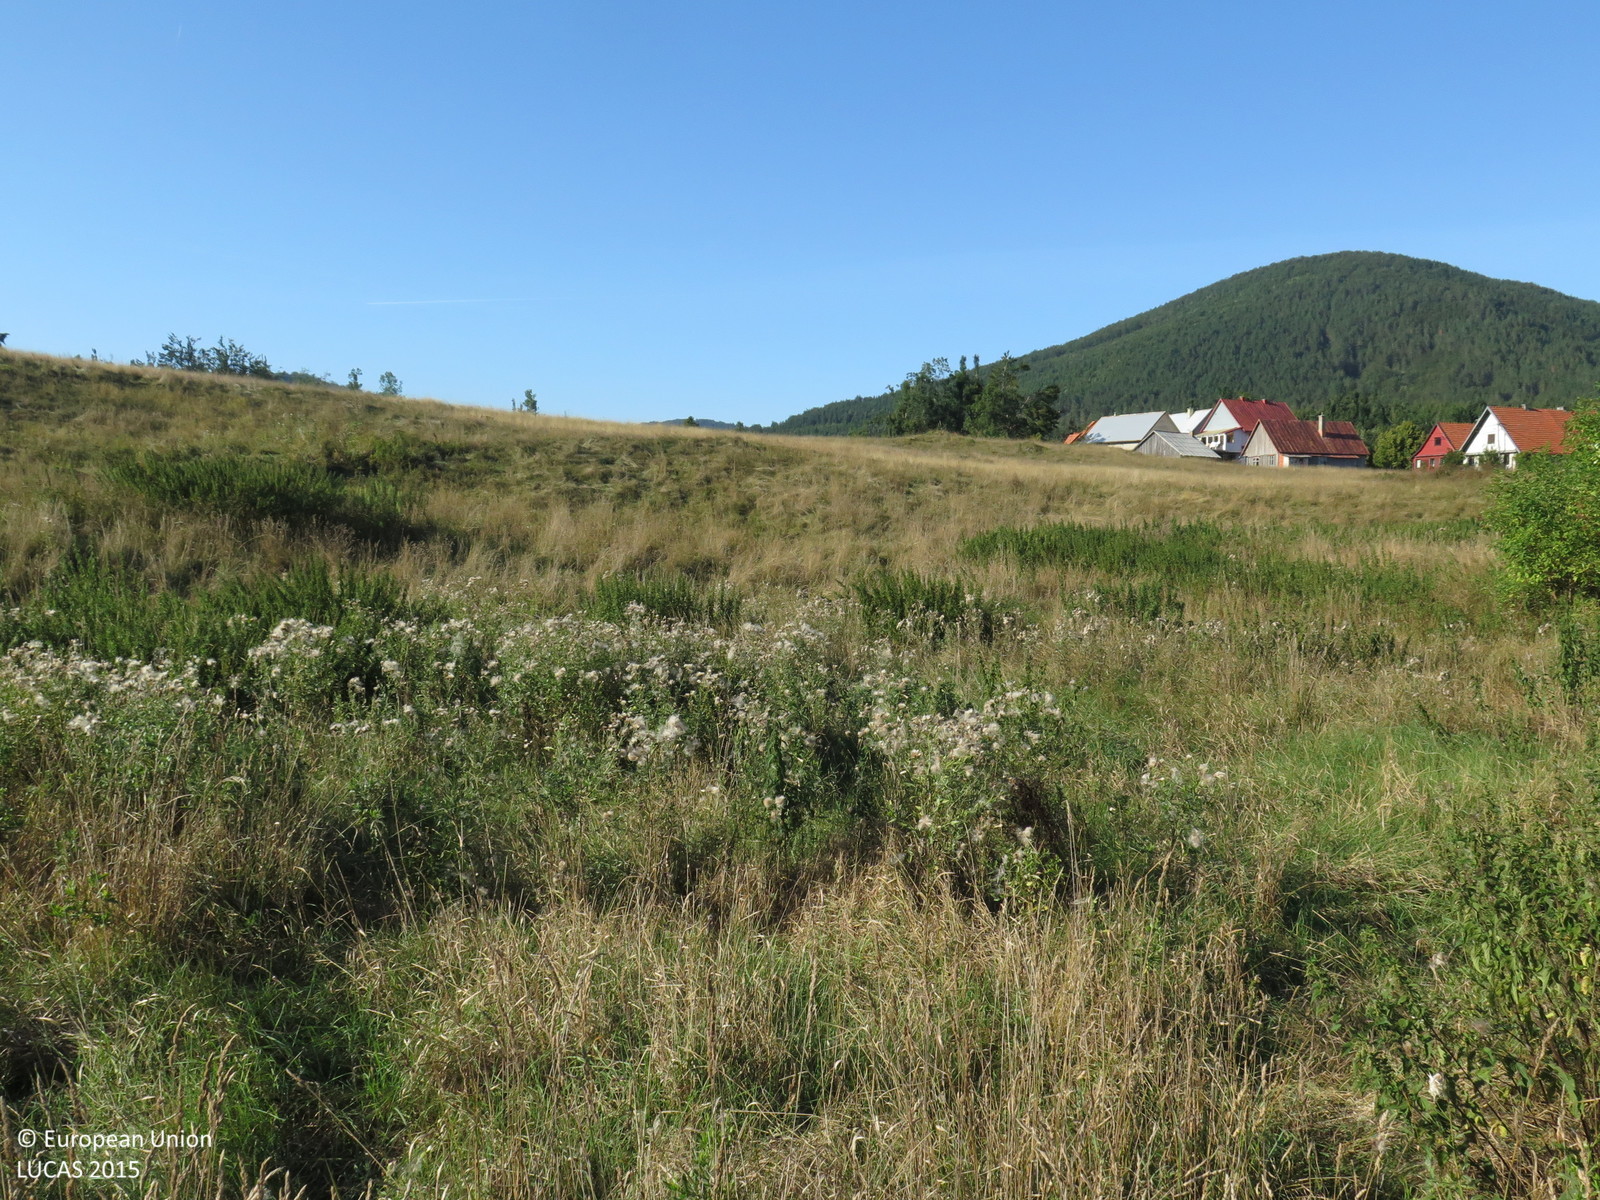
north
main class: Grassland
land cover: Grassland without tree/shrub cover
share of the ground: > 75 %
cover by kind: herbaceous plants 95 %, shrubs 5 %
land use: Agriculture (excluding fallow land and kitchen gardens)
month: August
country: HR
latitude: 45.3205
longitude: 14.8556
